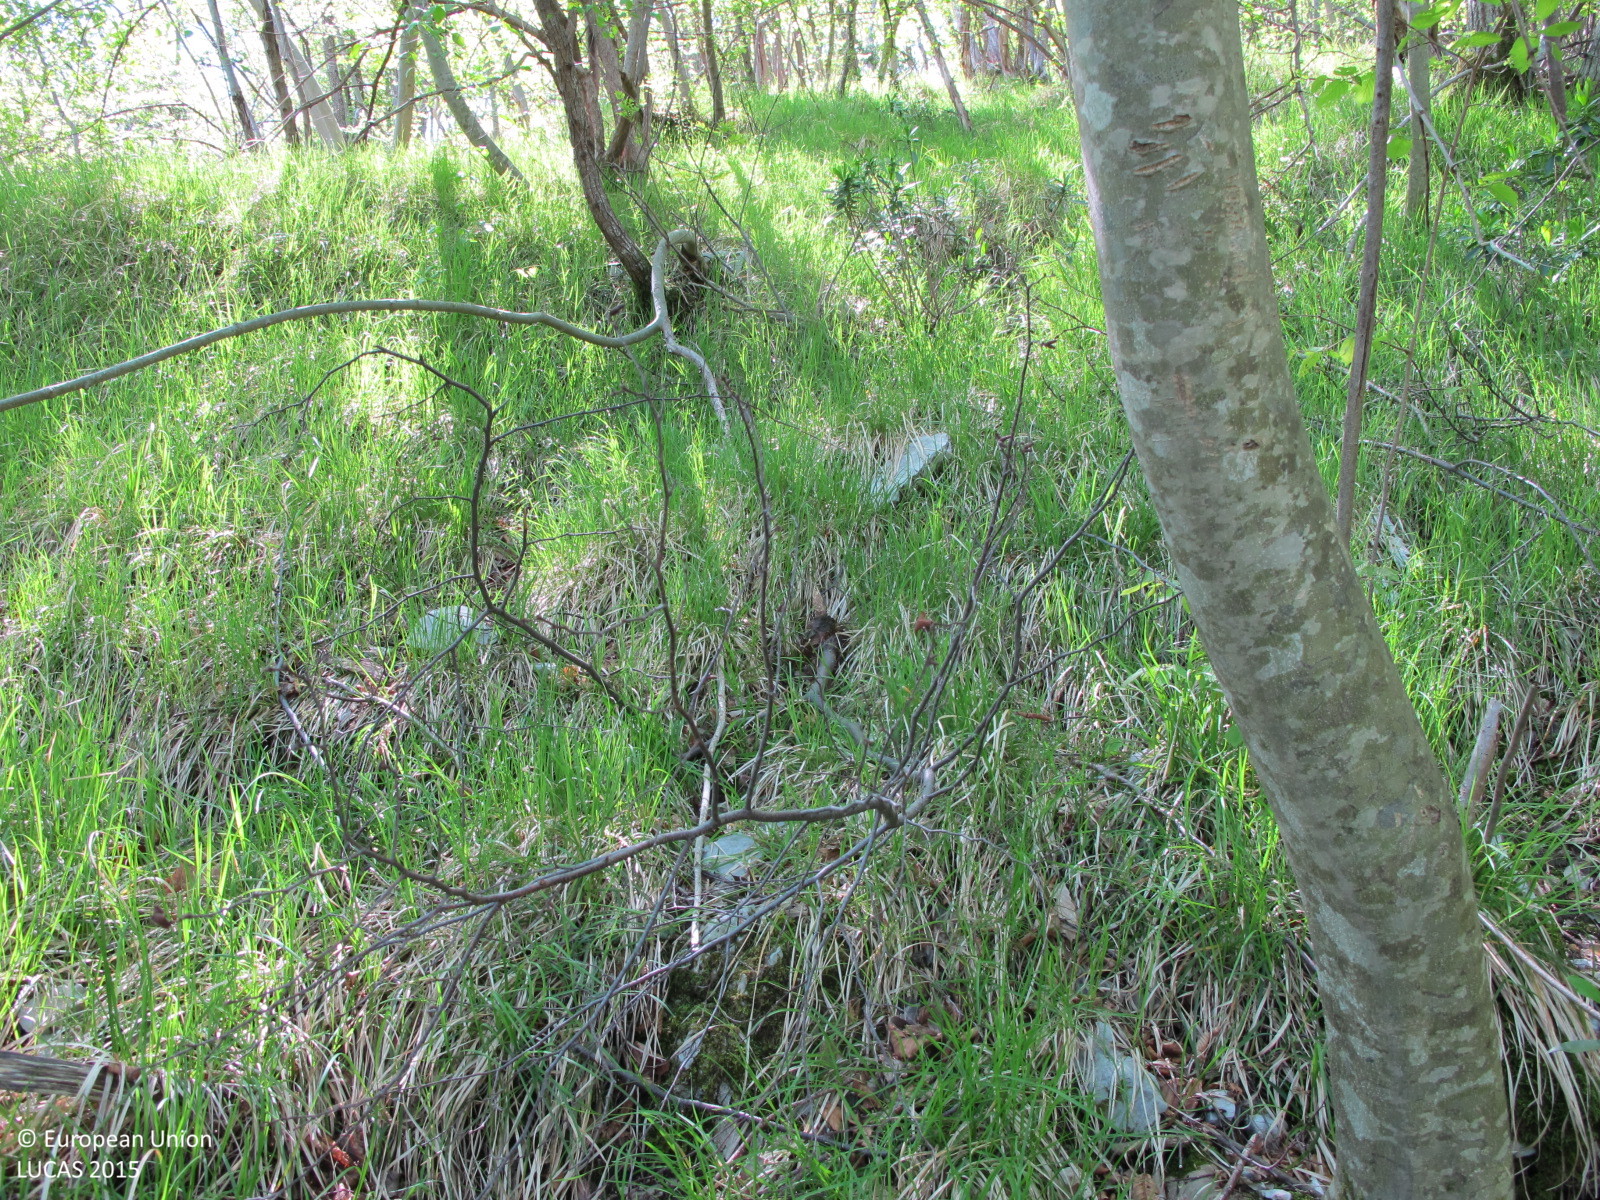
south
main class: Woodland
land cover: Broadleaved woodland
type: thermophilous deciduous forest
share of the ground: > 75 %
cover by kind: broadleaved forest trees 80 %, herbaceous plants 10 %, shrubs 5 %
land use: Forestry
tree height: > 5 m
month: April
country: HR
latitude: 45.2749
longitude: 14.2396
